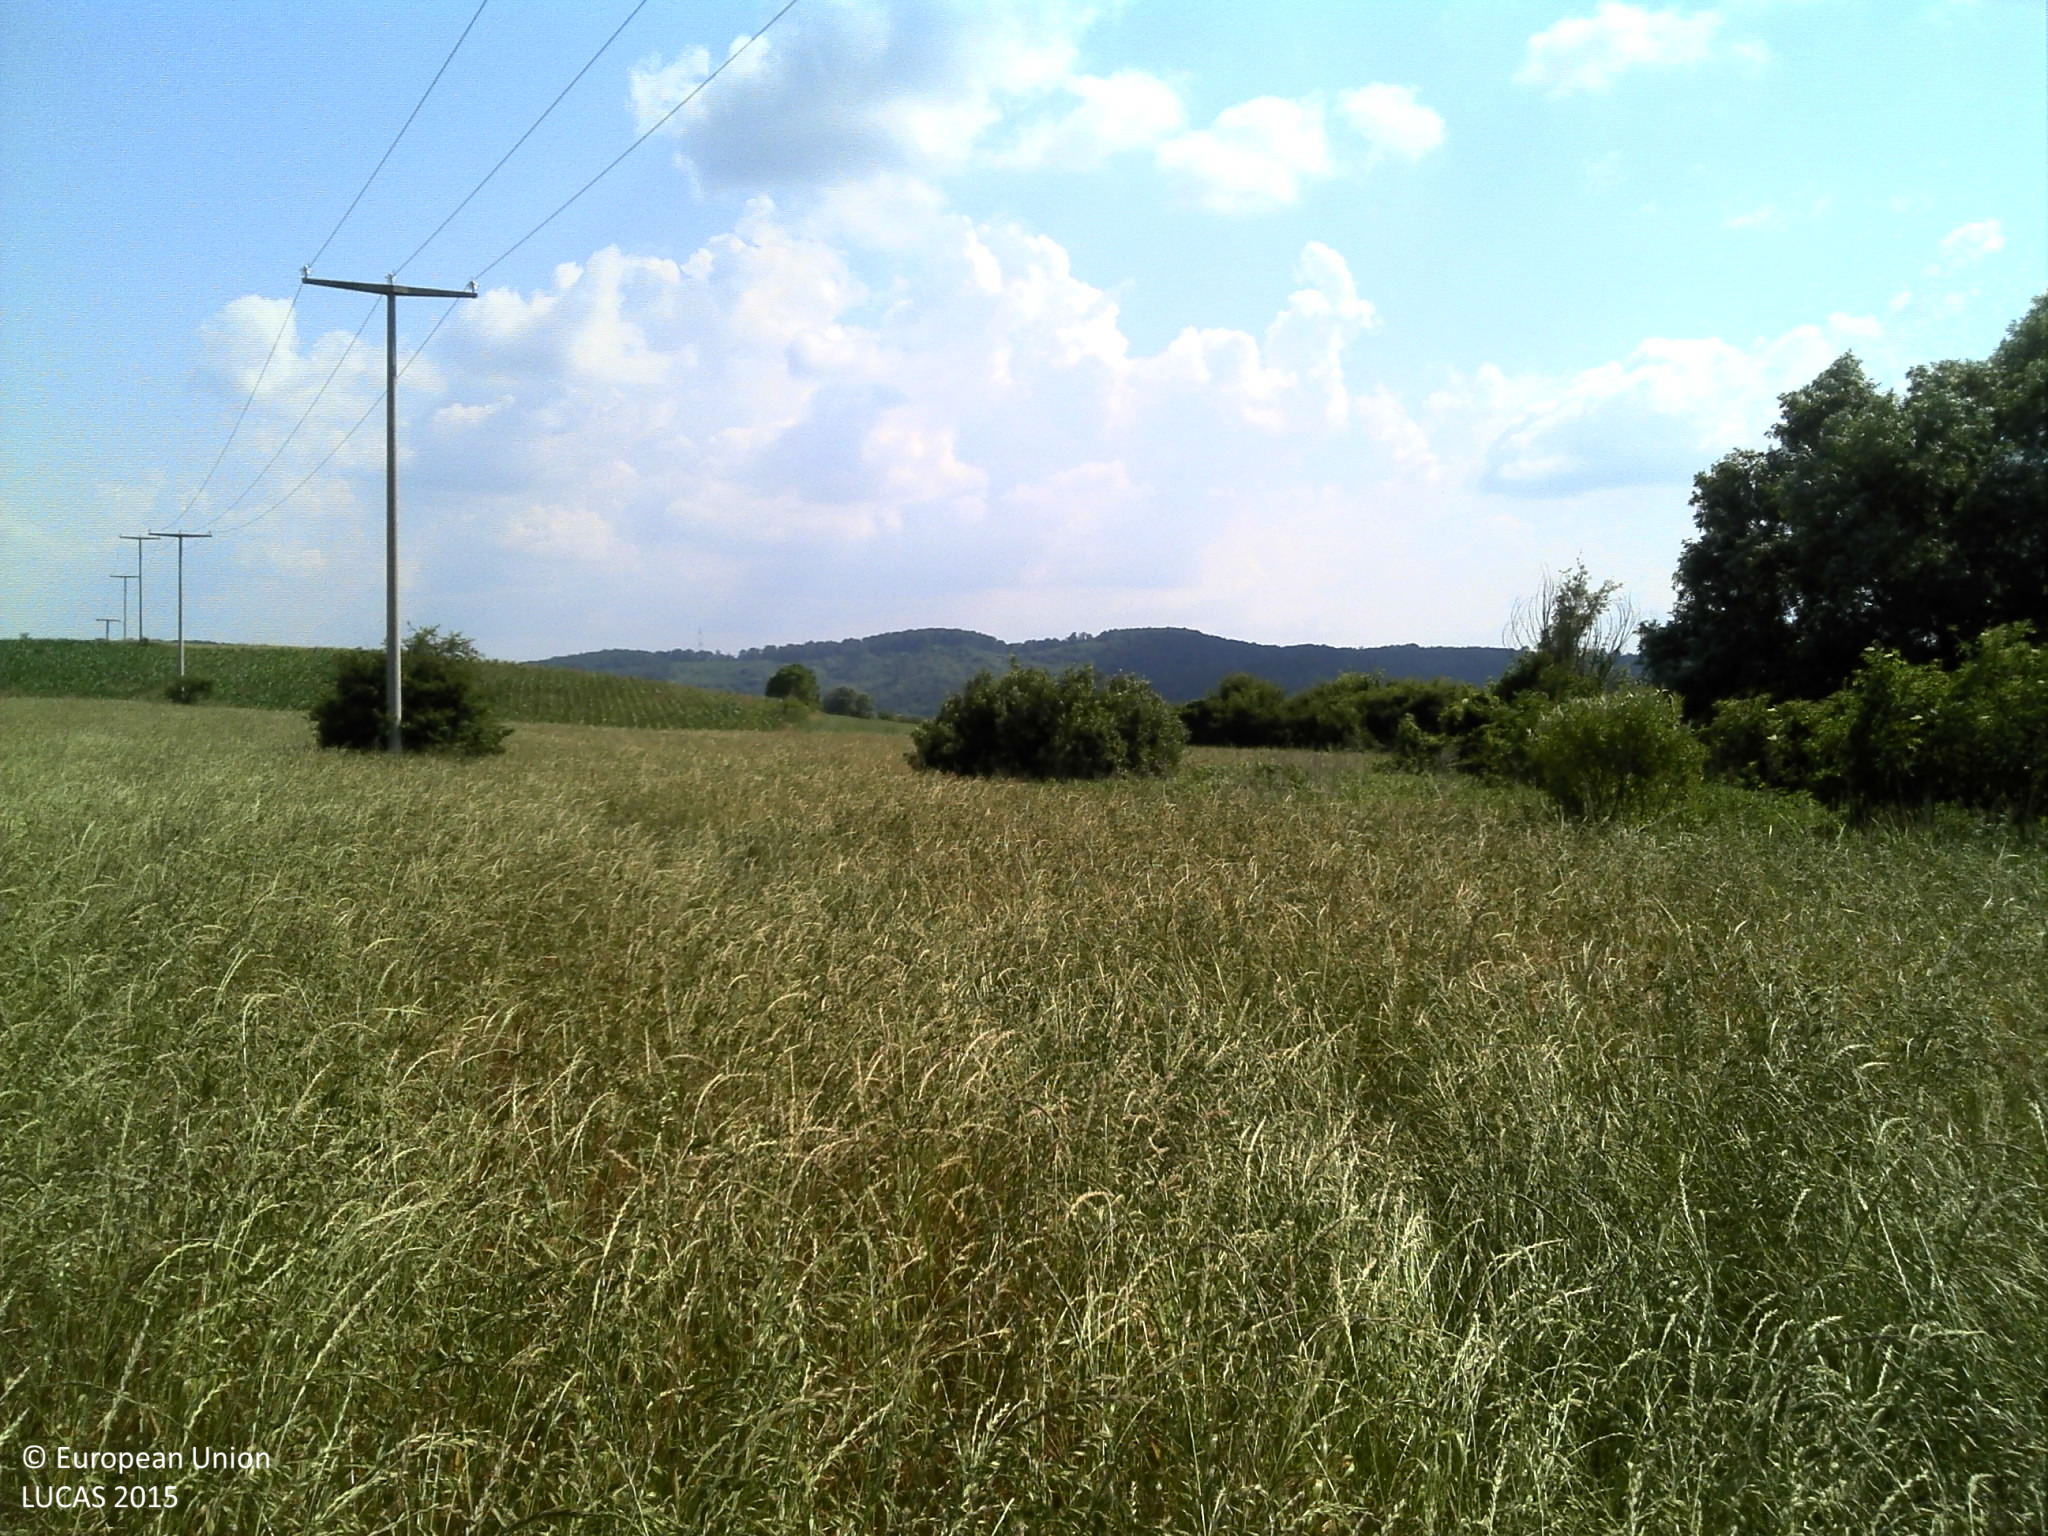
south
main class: Cropland
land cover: Mixed cereals for fodder
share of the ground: > 75 %
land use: Agriculture (excluding fallow land and kitchen gardens)
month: June
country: HR
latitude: 45.2375
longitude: 17.9897
